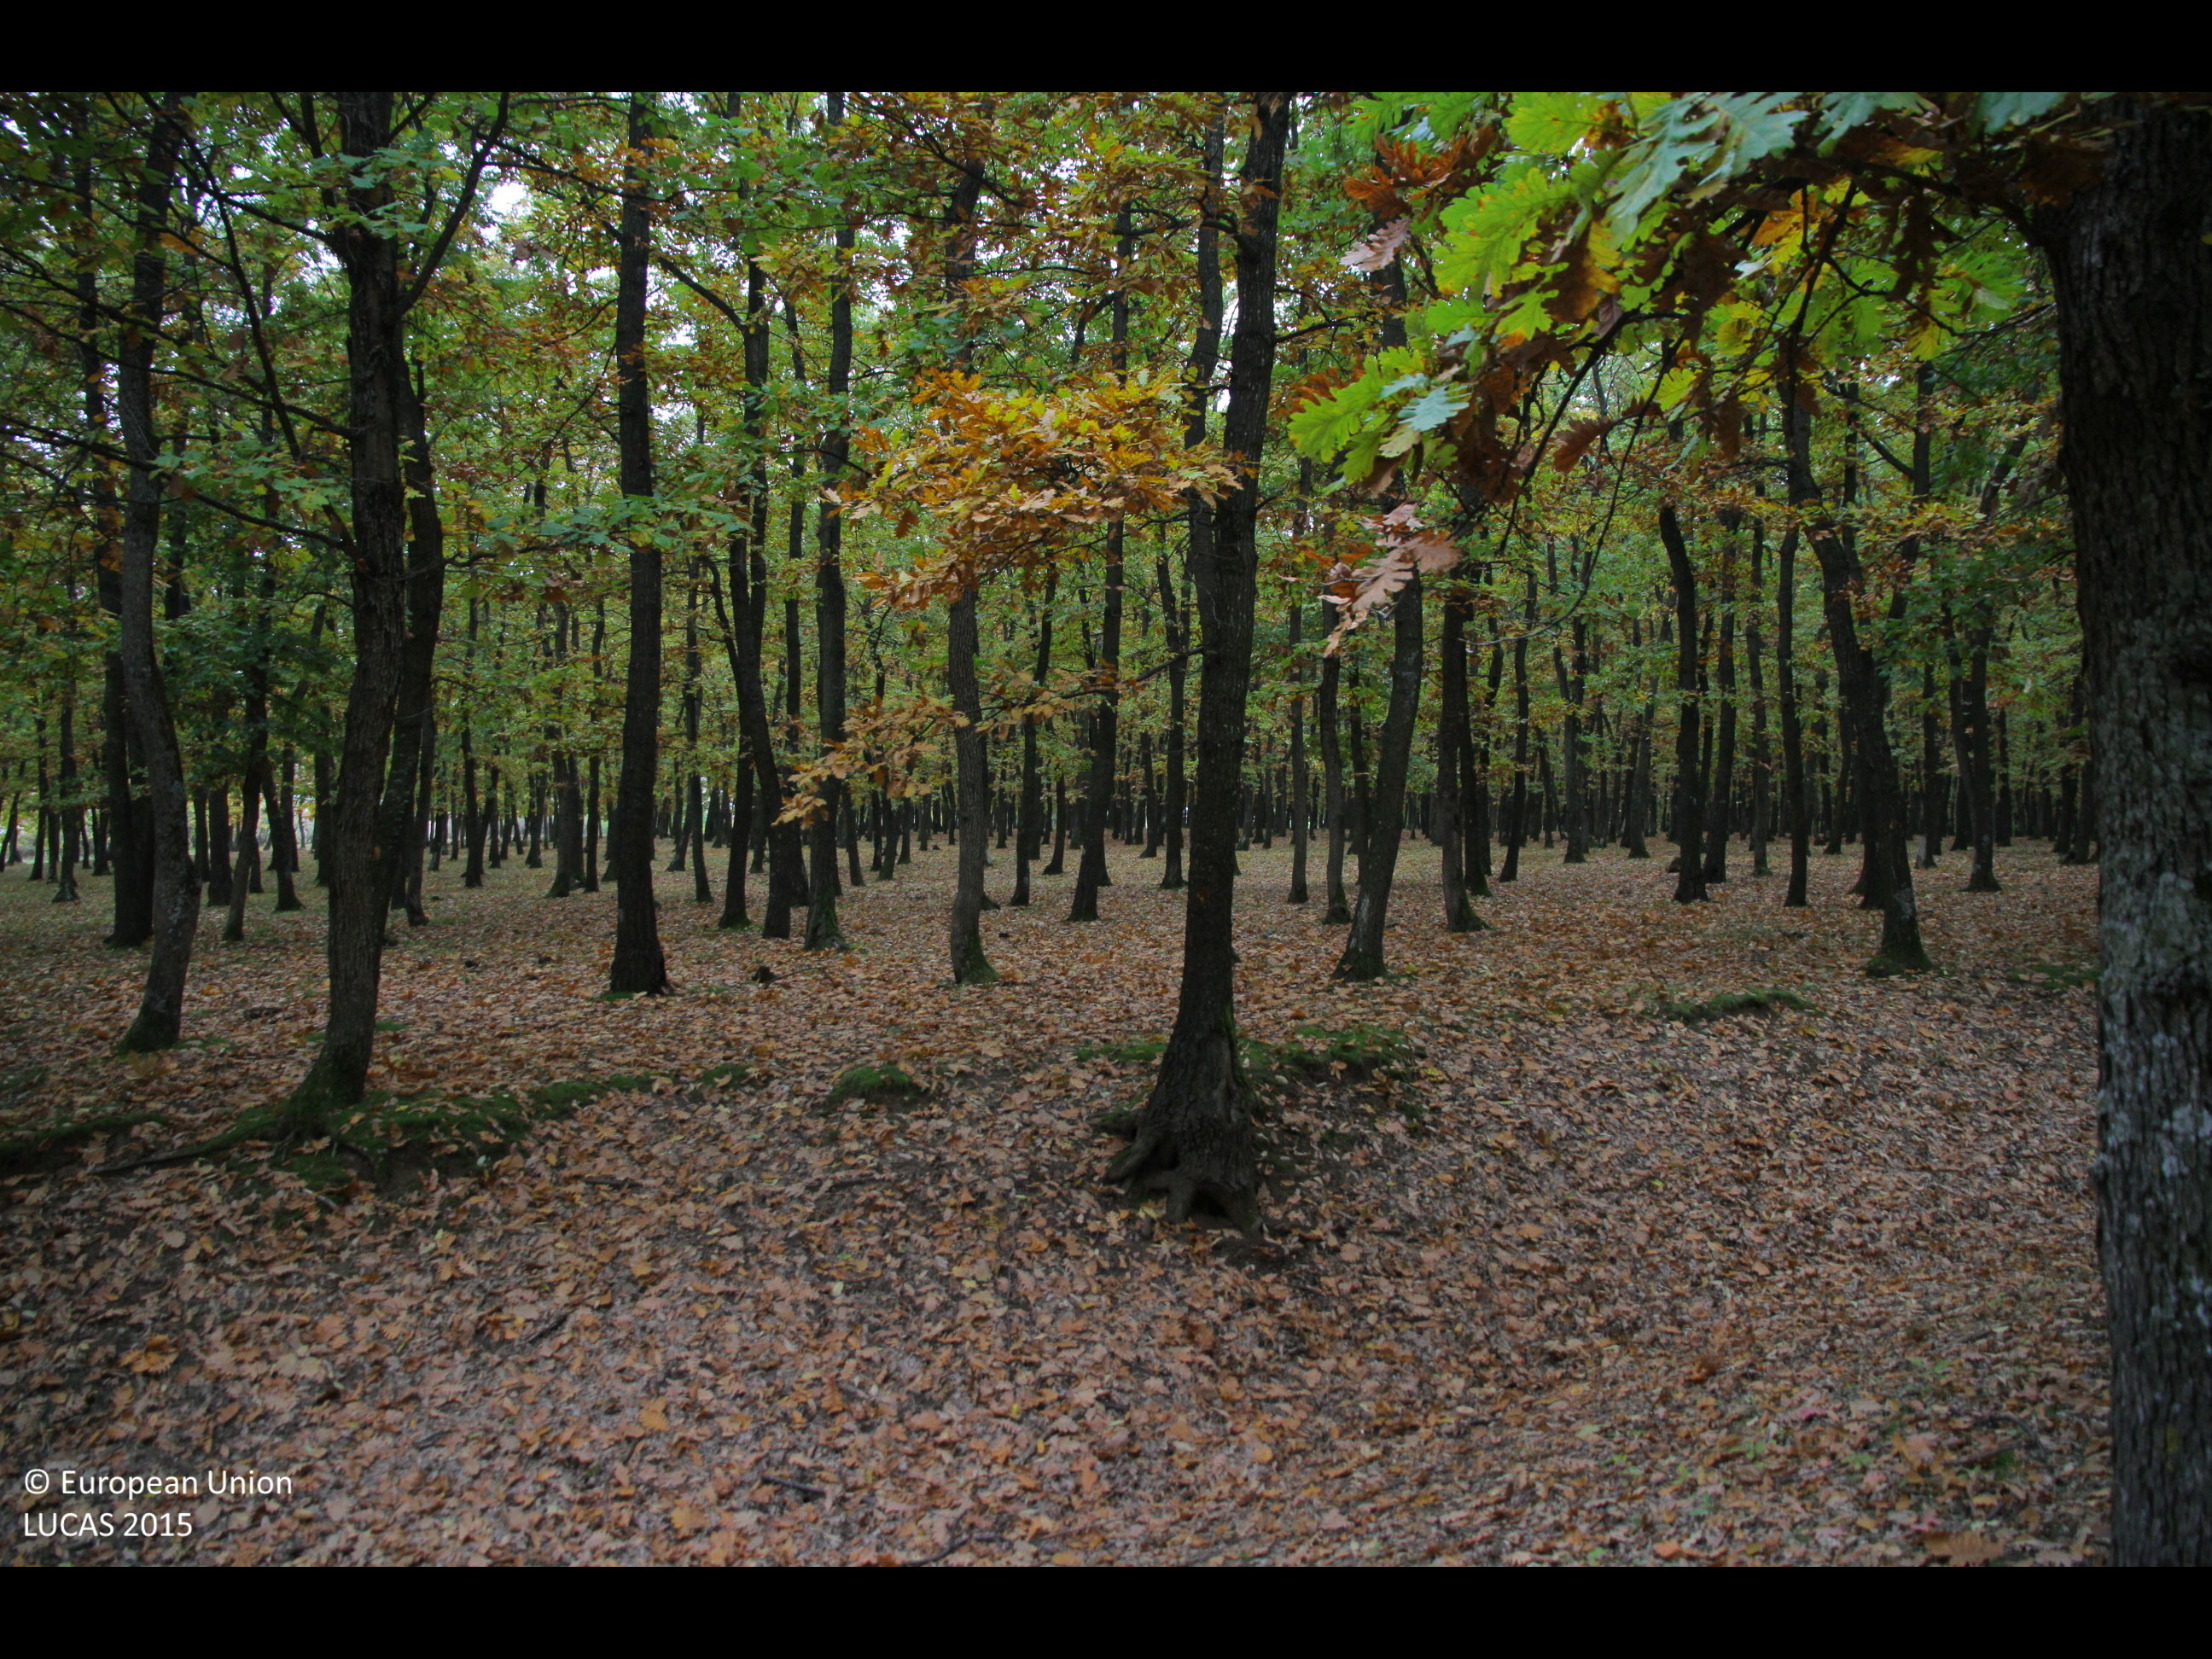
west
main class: Woodland
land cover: Broadleaved woodland
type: mesophytic deciduous forest
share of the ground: > 75 %
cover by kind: broadleaved forest trees 100 %
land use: Forestry
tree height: > 5 m
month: October
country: BG
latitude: 43.4543
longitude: 26.7570
